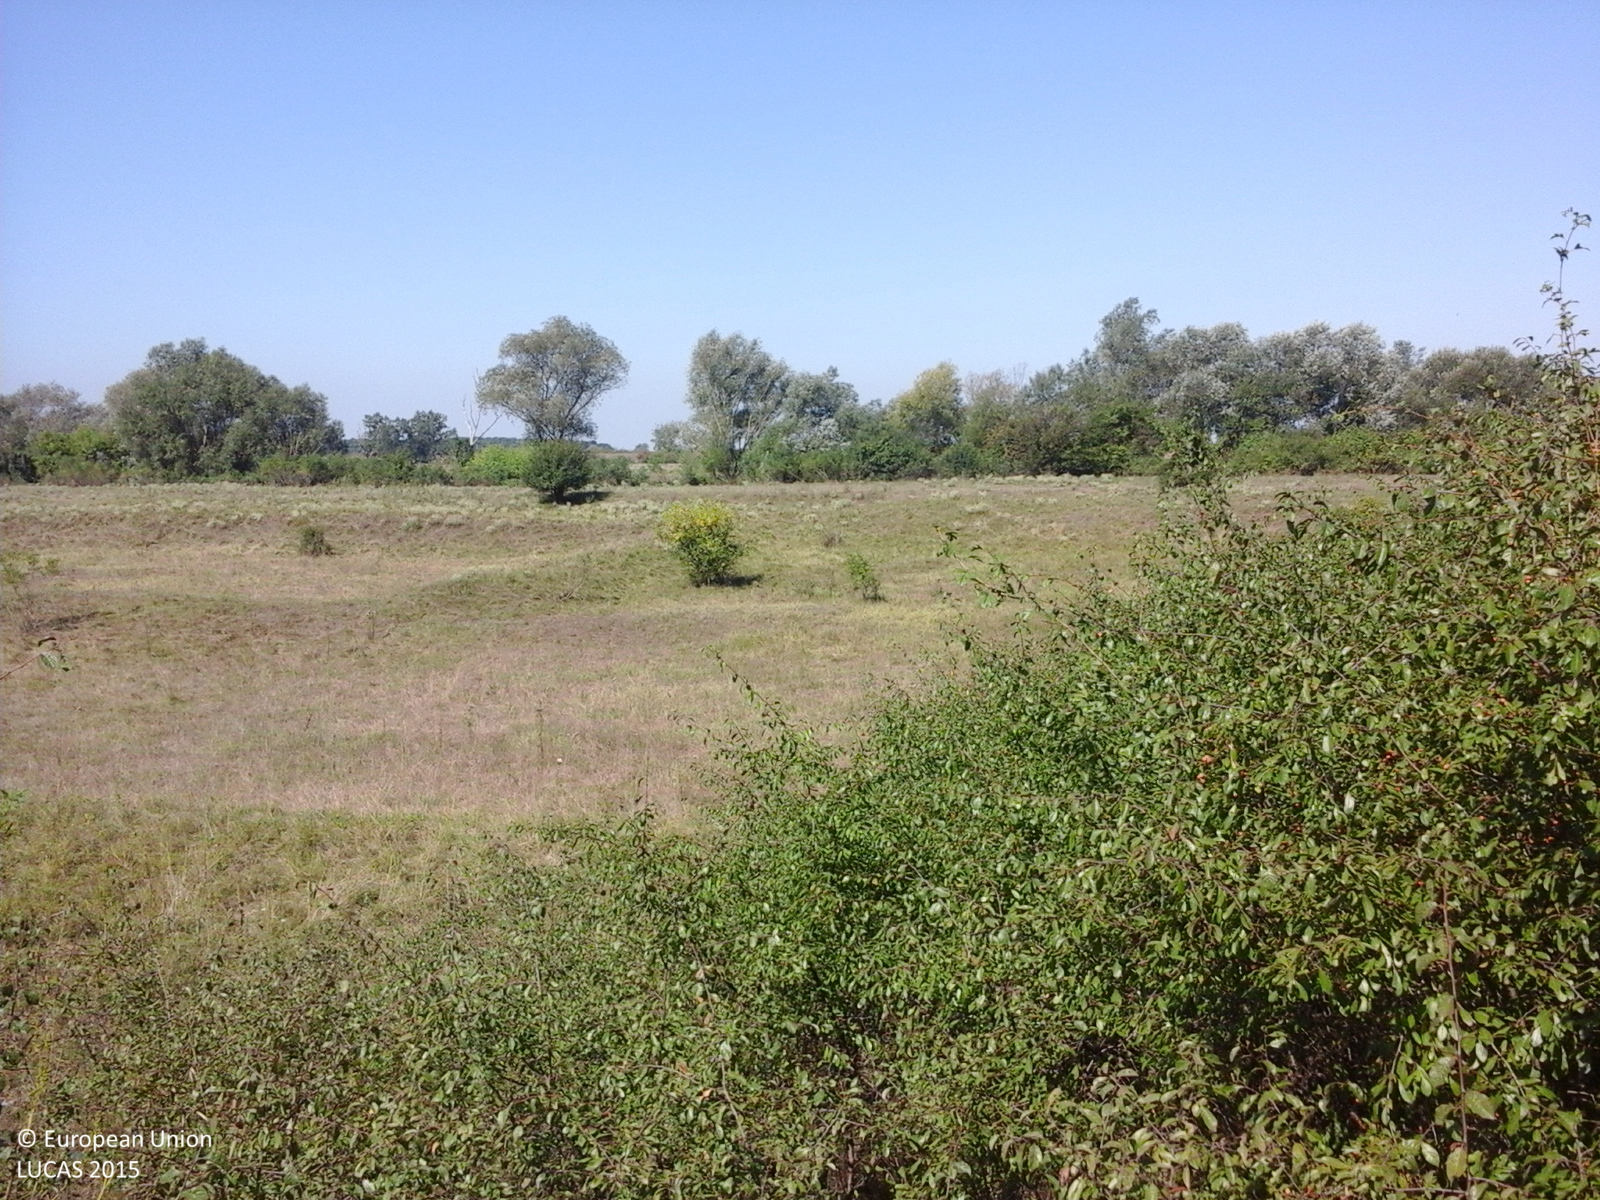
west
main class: Shrubland
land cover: Shrubland with sparse tree cover
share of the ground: > 75 %
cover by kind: shrubs 95 %, broadleaved forest trees 5 %
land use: Semi-natural and natural areas not in use
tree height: < 5 m
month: August
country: RO
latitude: 45.6609
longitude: 21.2863
